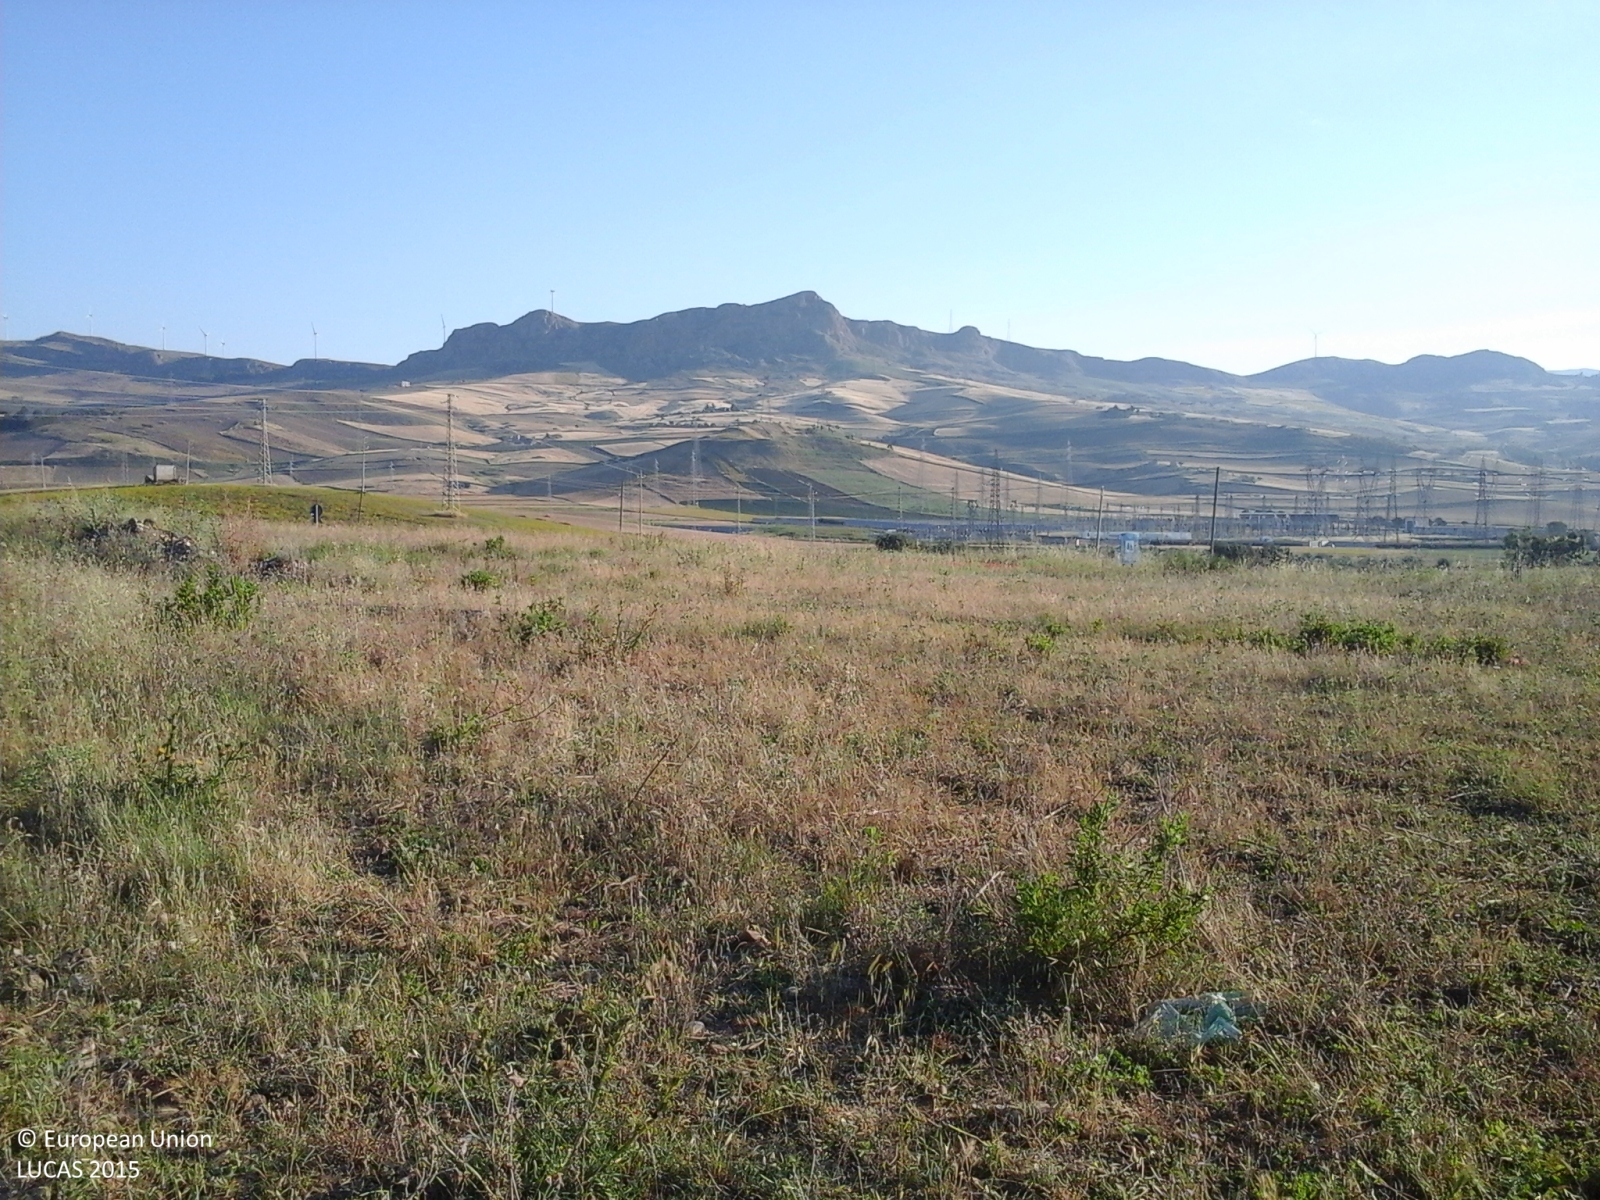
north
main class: Grassland
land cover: Spontaneously vegetated surfaces
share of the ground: > 75 %
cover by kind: herbaceous plants 100 %
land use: Fallow land
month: June
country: IT
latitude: 37.8644
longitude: 13.5098
